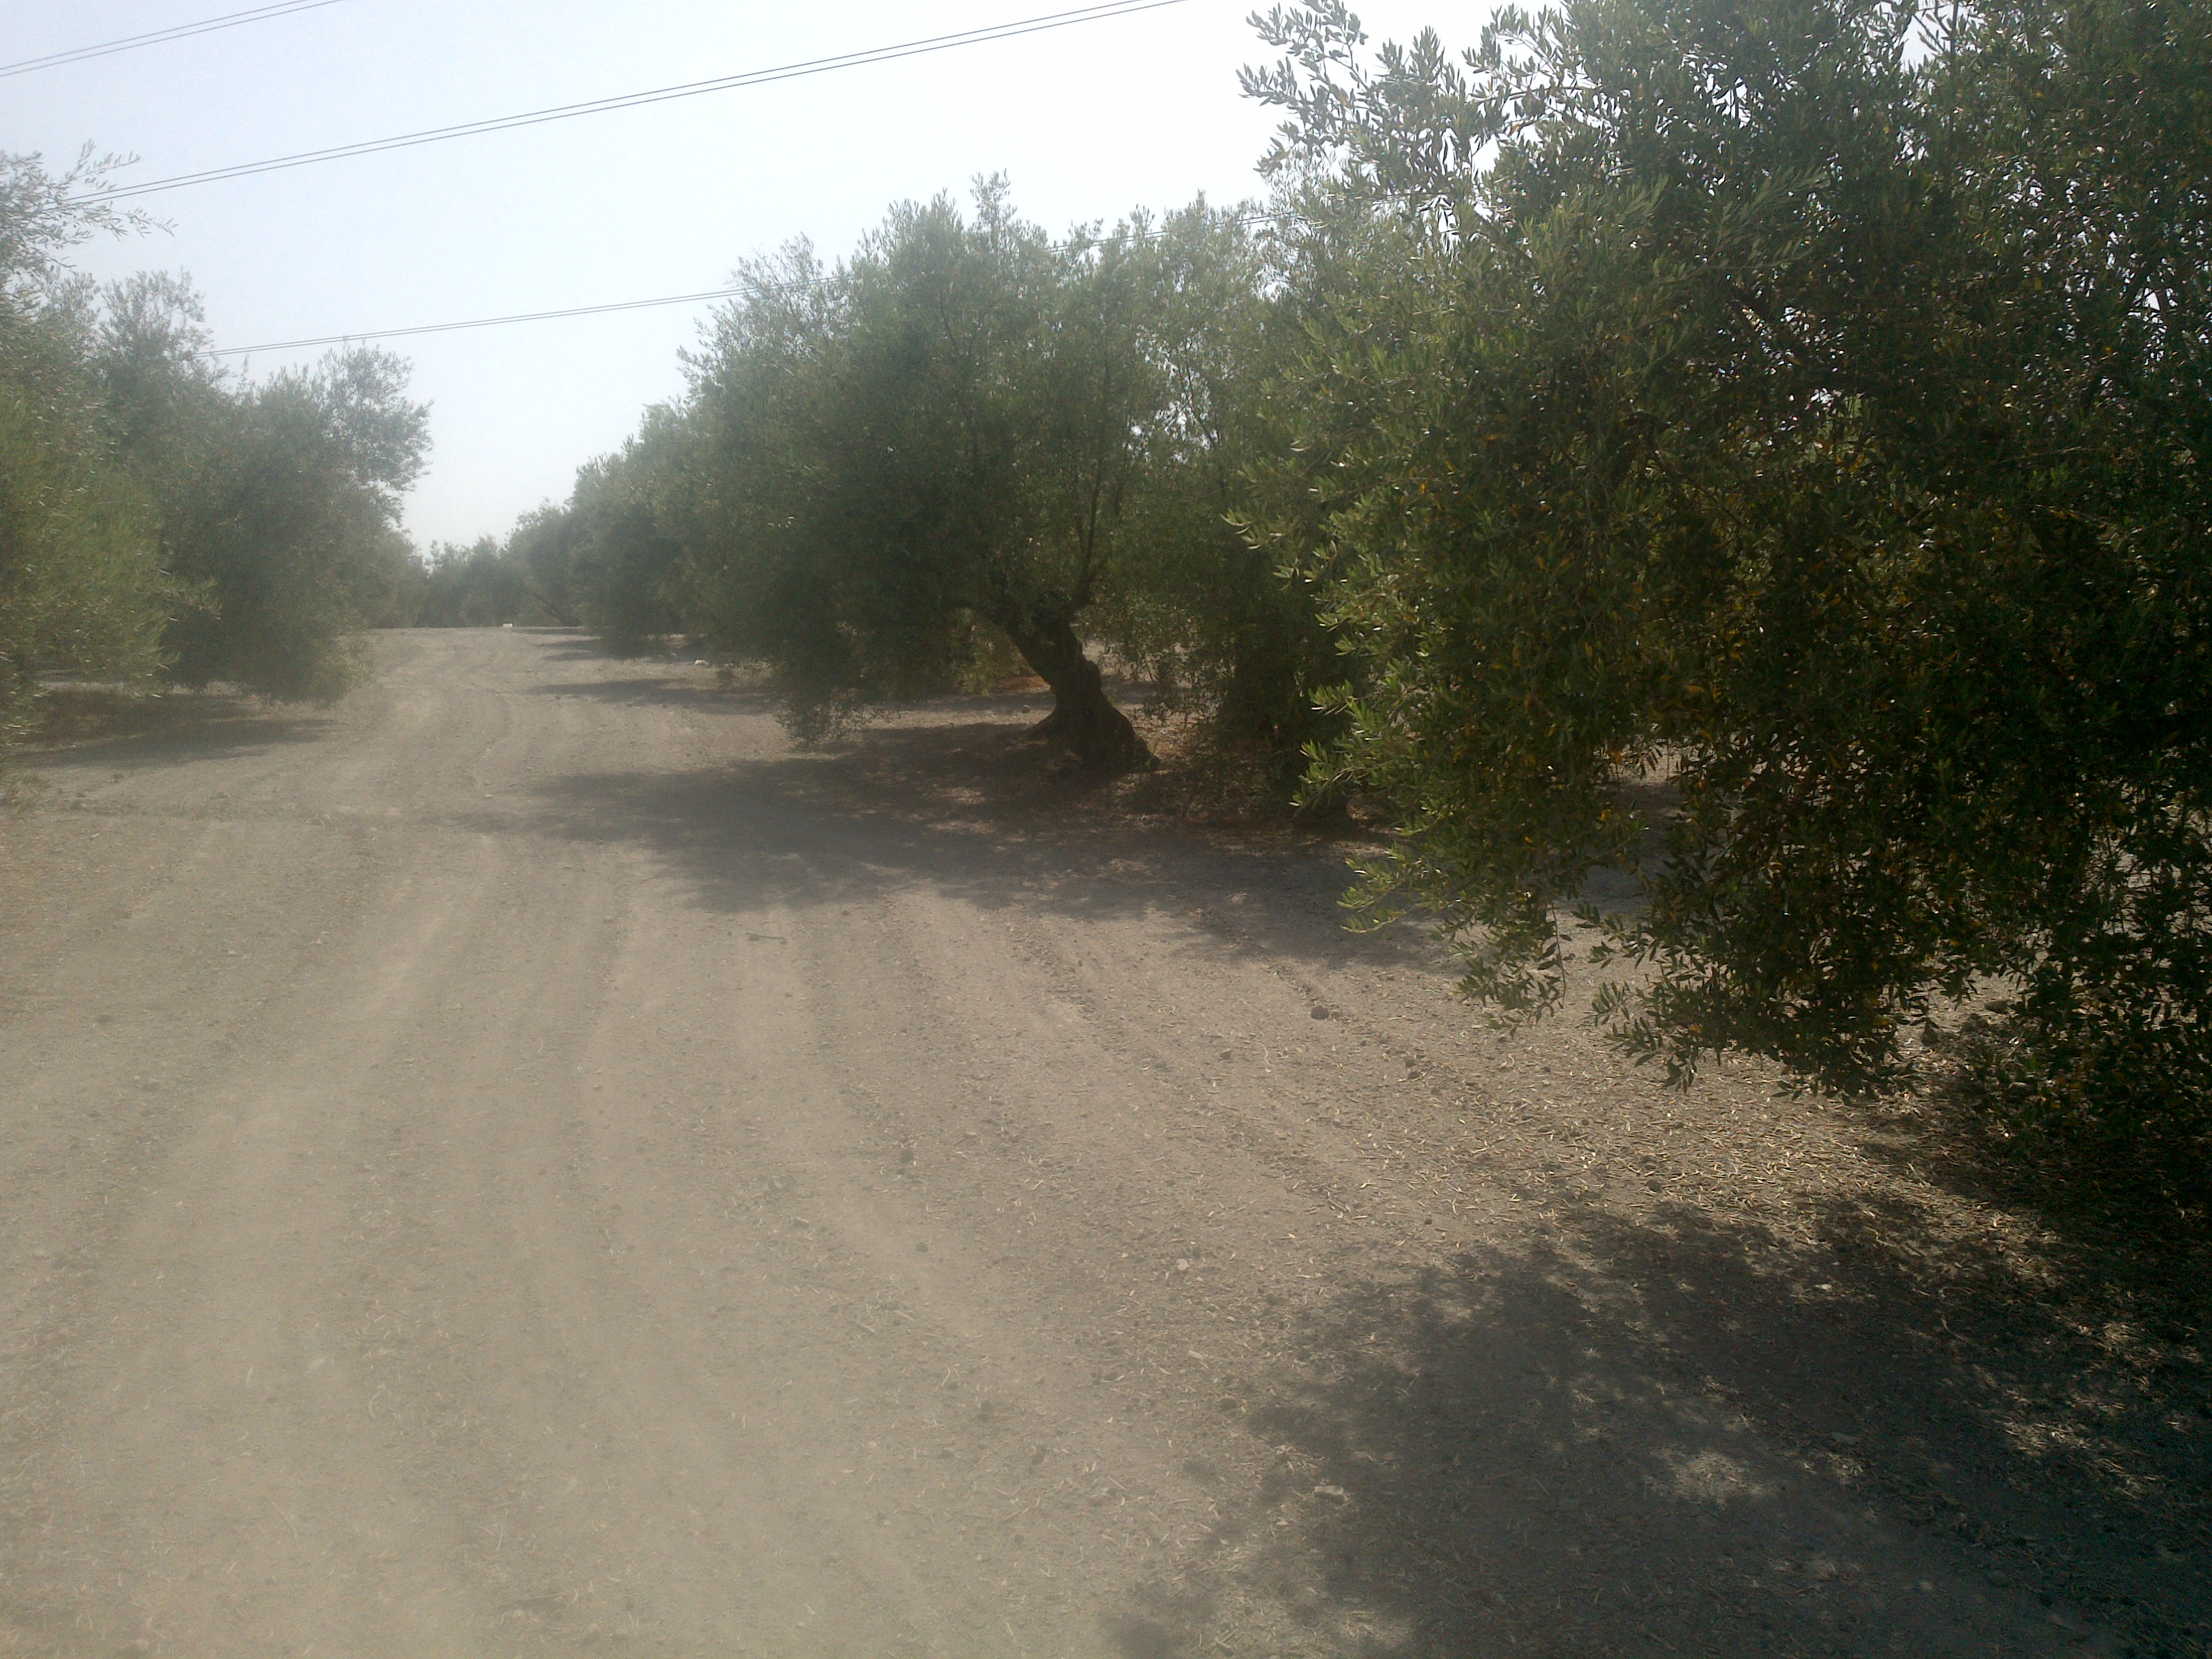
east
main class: Cropland
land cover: Olive groves
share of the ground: 50 - 75 %
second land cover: Other bare soil
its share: > 75 %
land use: Agriculture (excluding fallow land and kitchen gardens)
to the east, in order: Olive groves; Other bare soil; Electric lines; Olive groves; Artificial constructions in urban areas; Olive groves
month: July
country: ES
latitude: 37.3958
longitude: -4.5408
